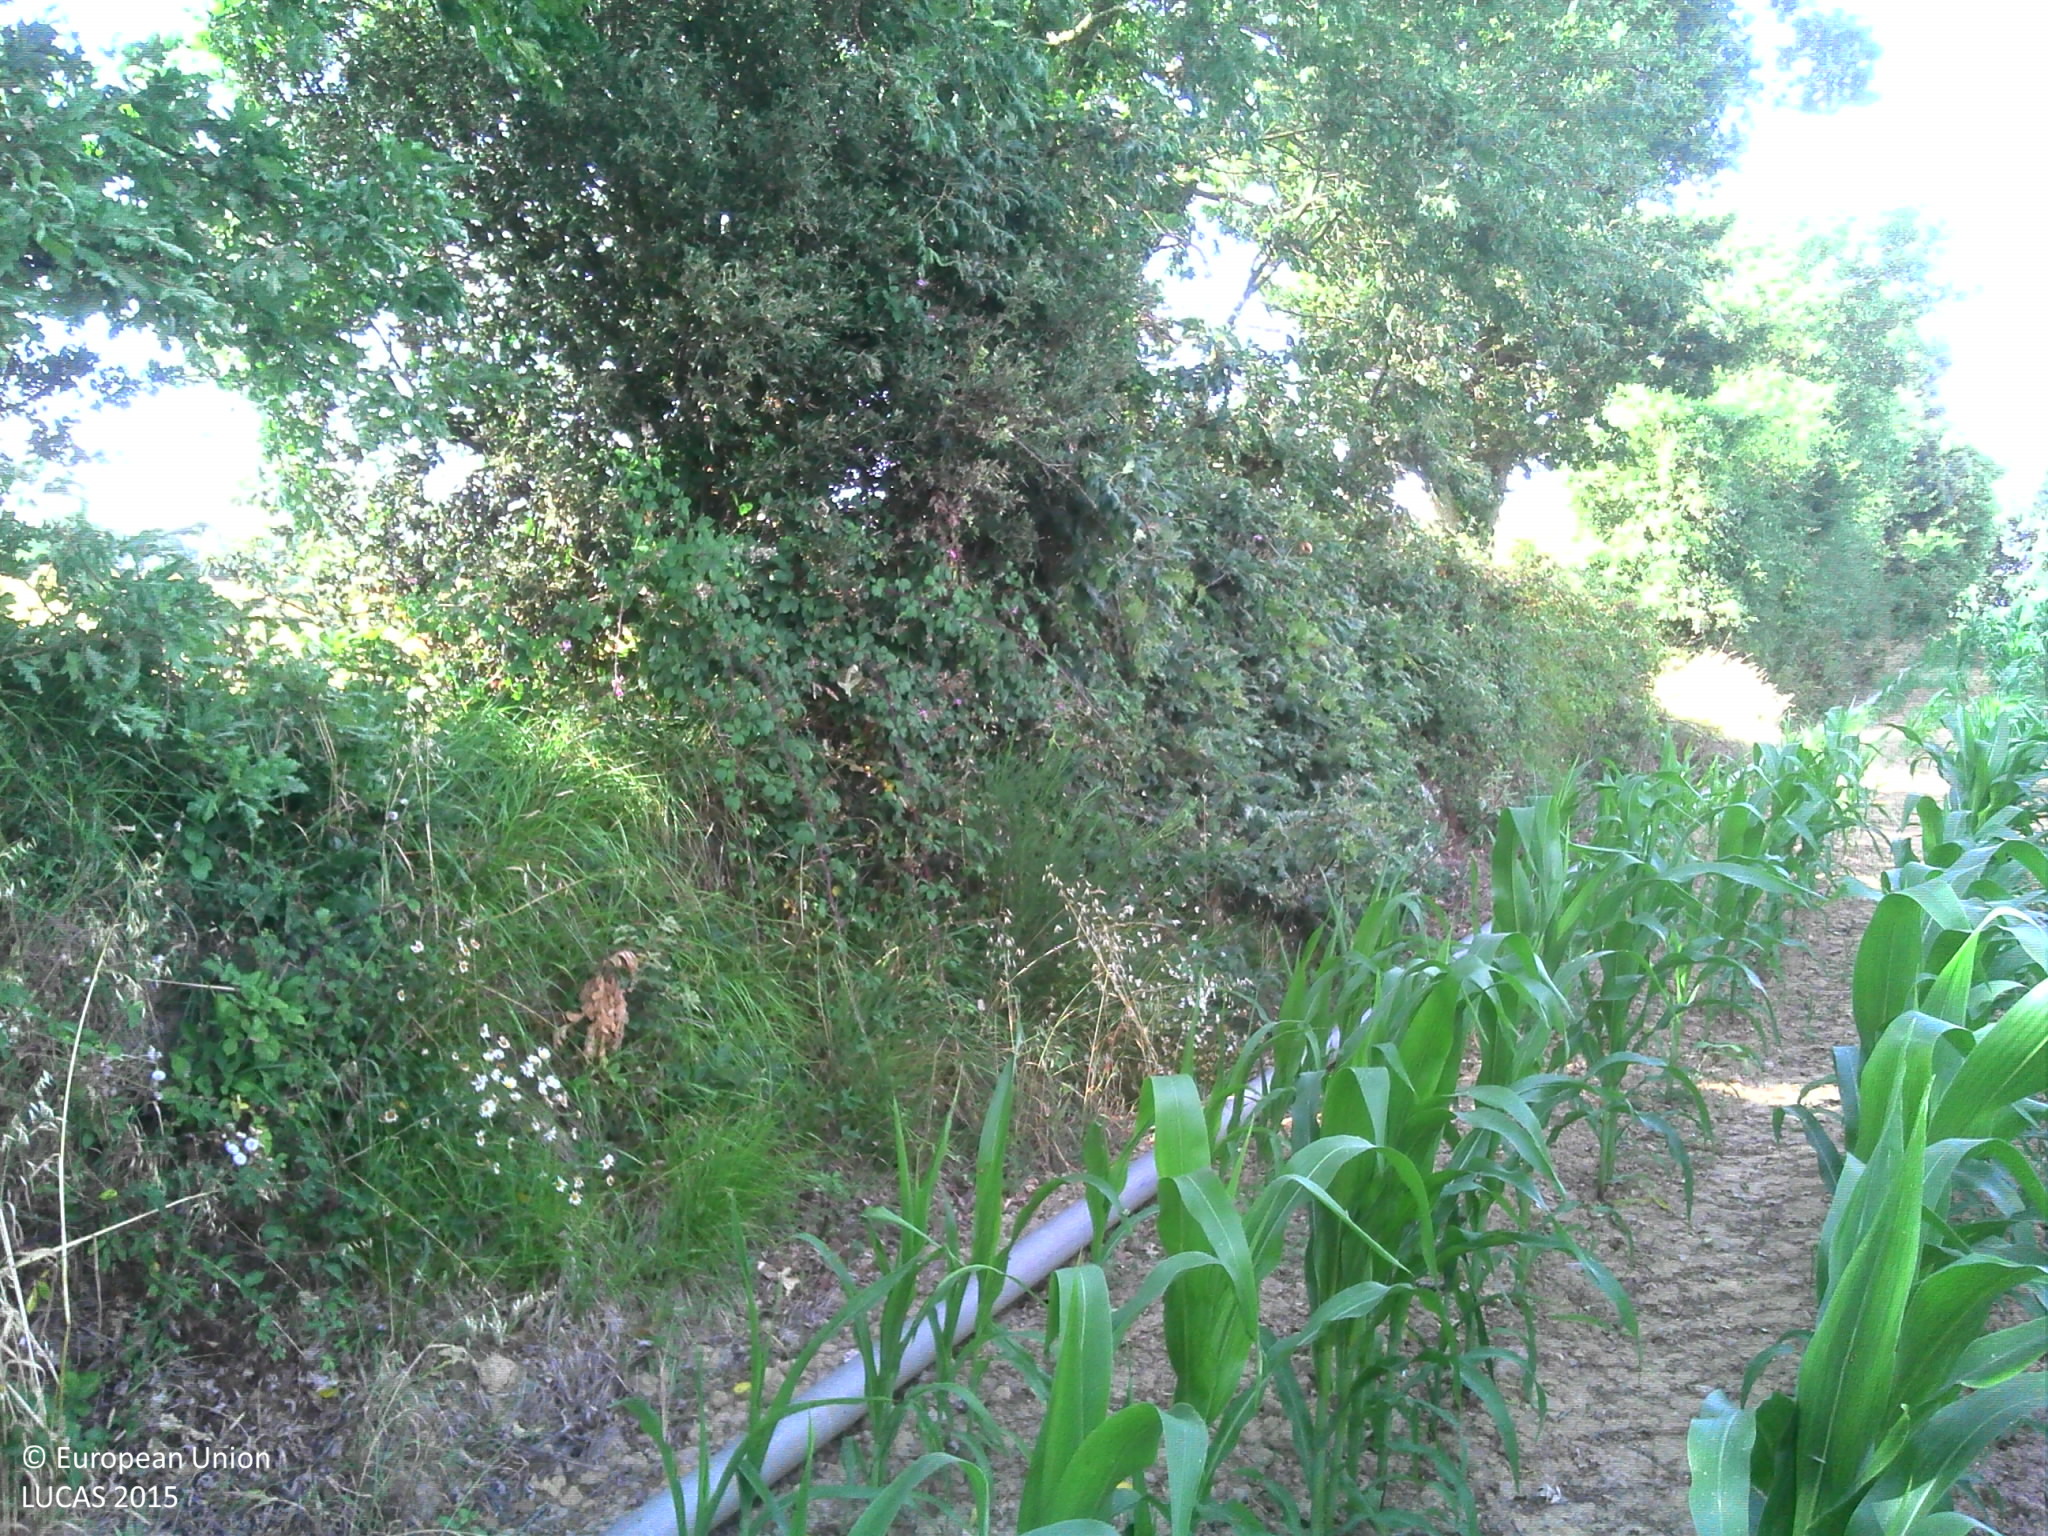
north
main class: Cropland
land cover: Maize
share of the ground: > 75 %
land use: Agriculture (excluding fallow land and kitchen gardens)
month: July
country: FR
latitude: 46.5179
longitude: -1.6008
